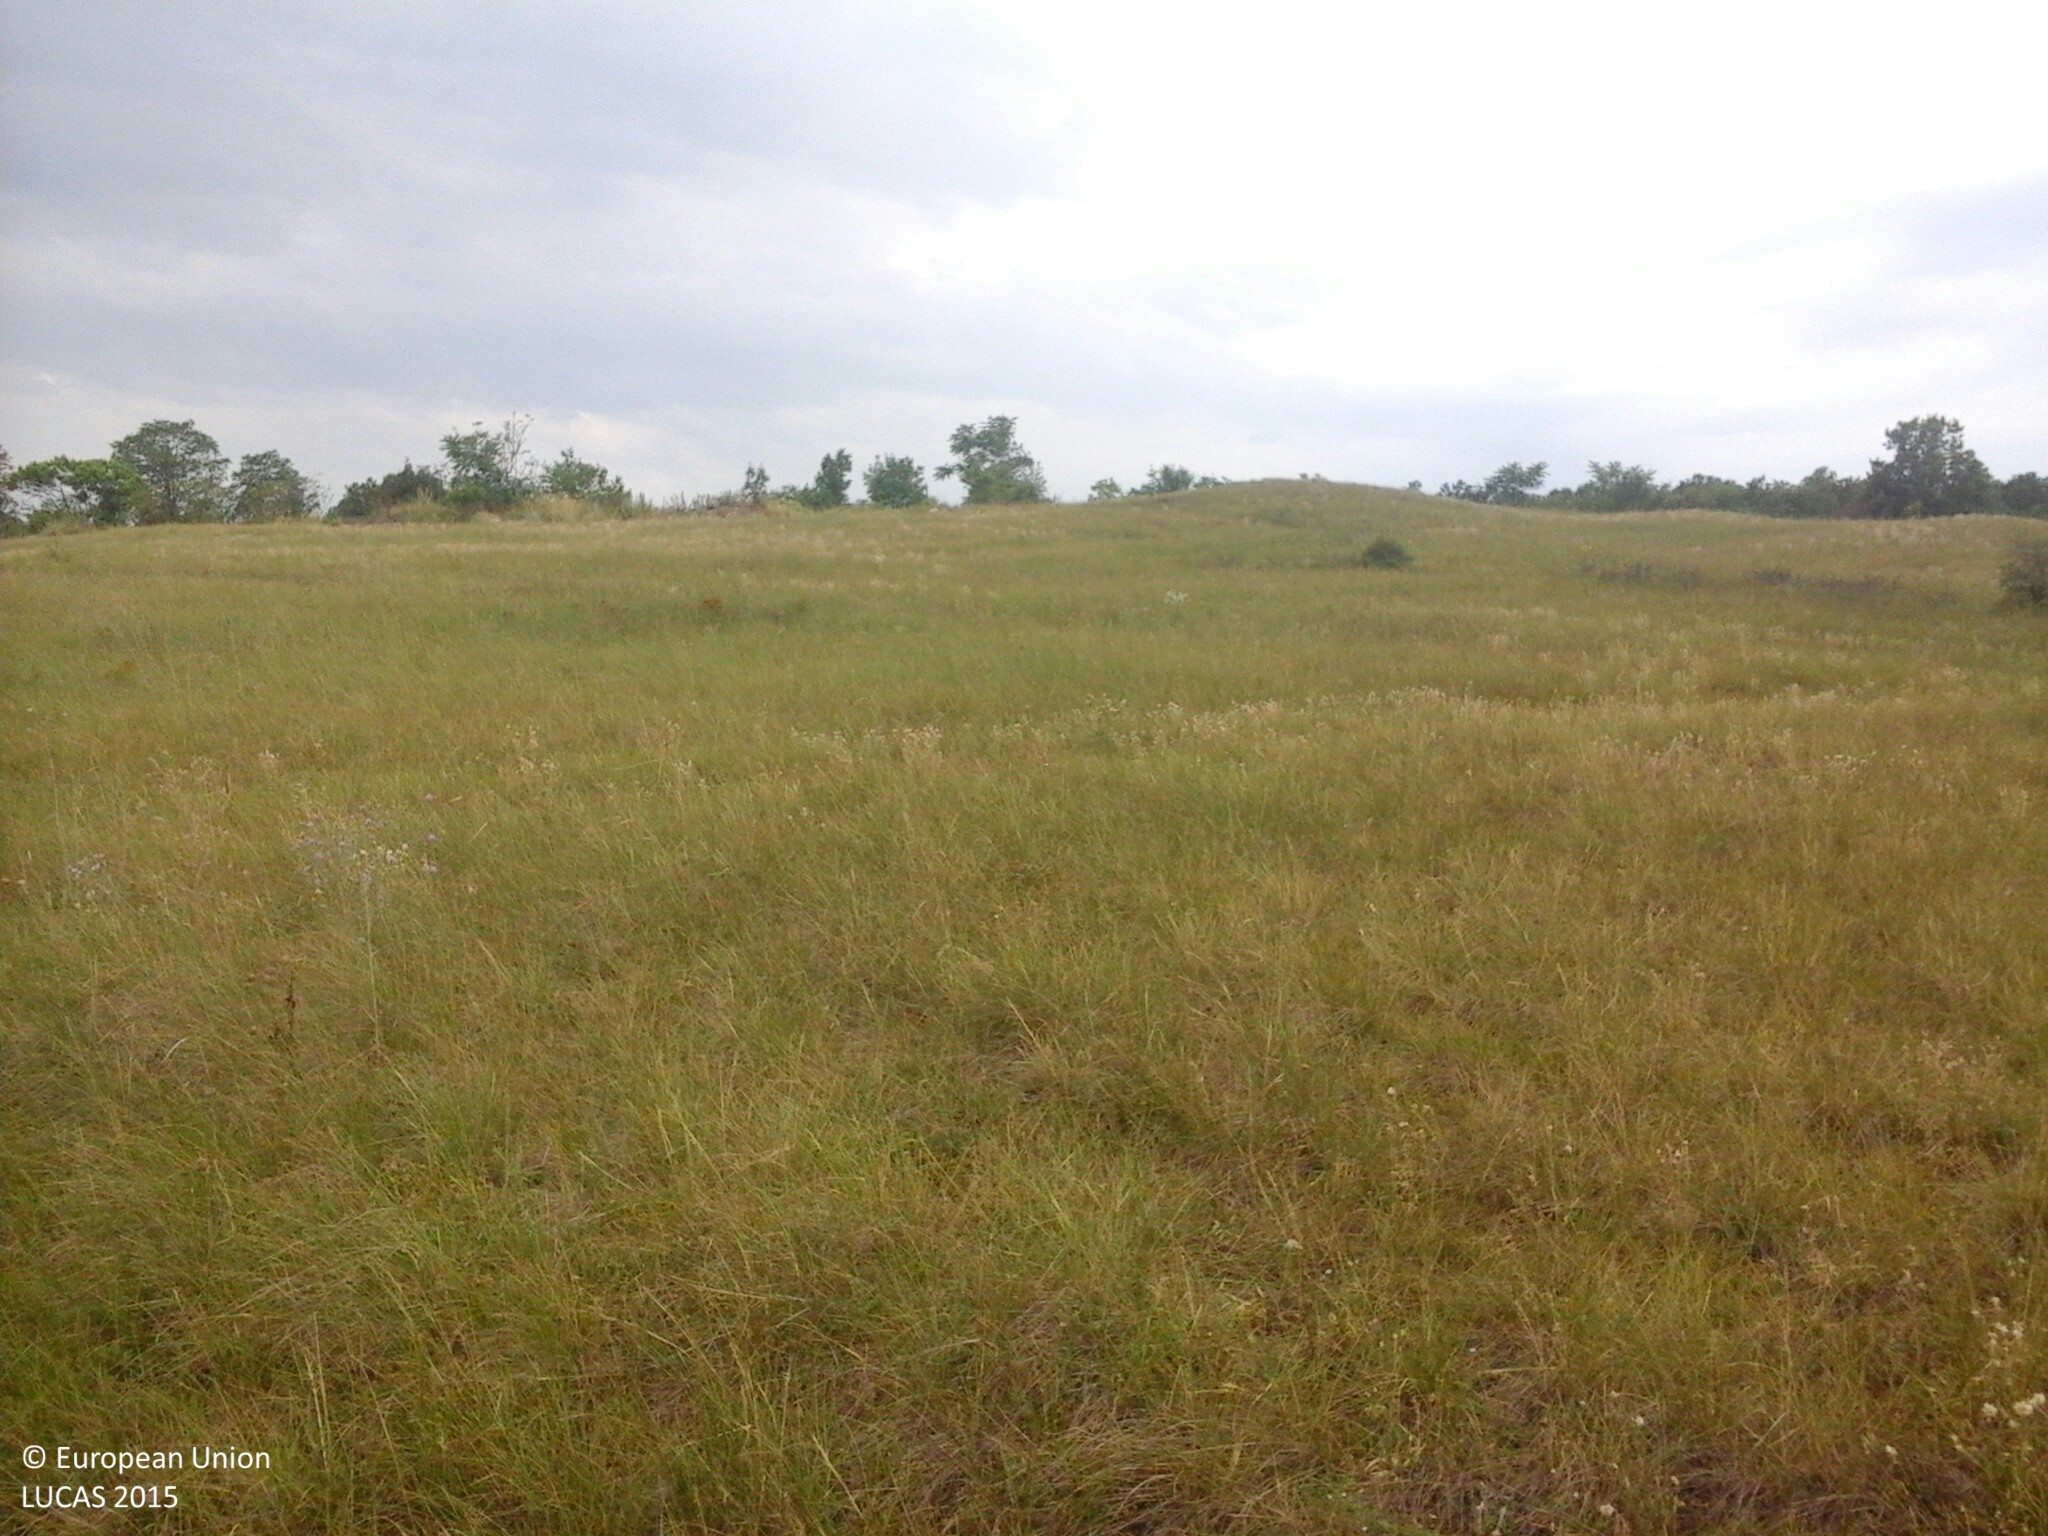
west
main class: Grassland
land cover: Grassland without tree/shrub cover
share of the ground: > 75 %
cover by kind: herbaceous plants 100 %
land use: Agriculture (excluding fallow land and kitchen gardens)
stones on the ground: 10 - 25 %
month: July
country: HU
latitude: 47.1498
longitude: 18.0679
